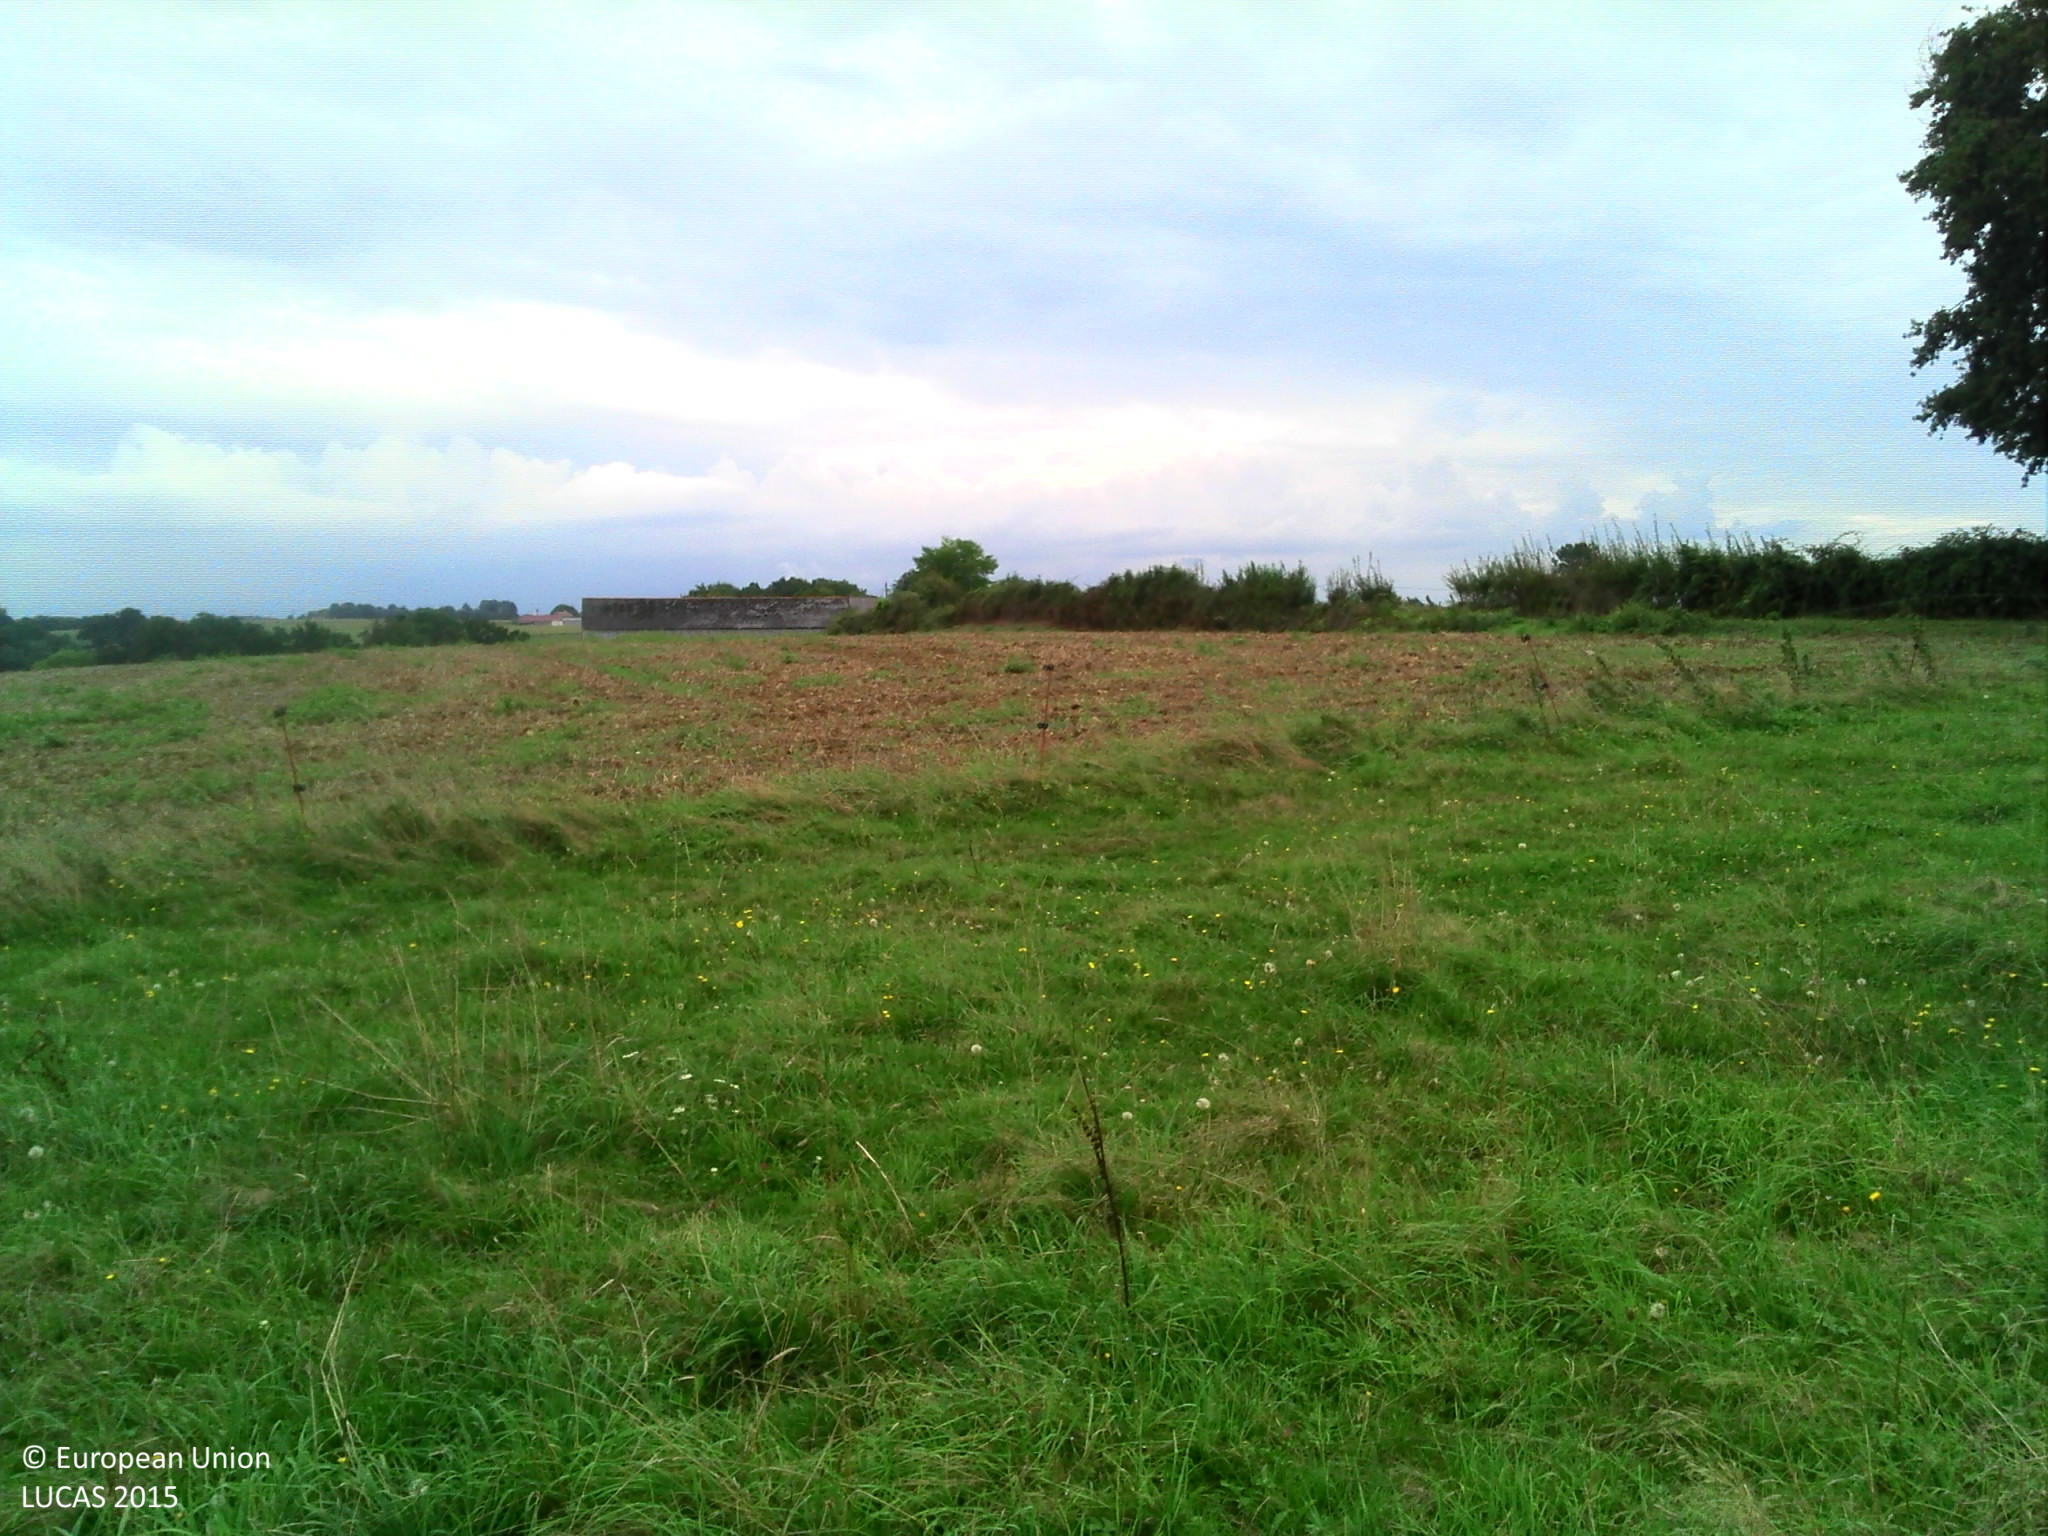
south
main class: Grassland
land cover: Grassland without tree/shrub cover
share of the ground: > 75 %
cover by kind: herbaceous plants 100 %
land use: Agriculture (excluding fallow land and kitchen gardens)
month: September
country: FR
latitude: 43.4136
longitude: -0.1700
